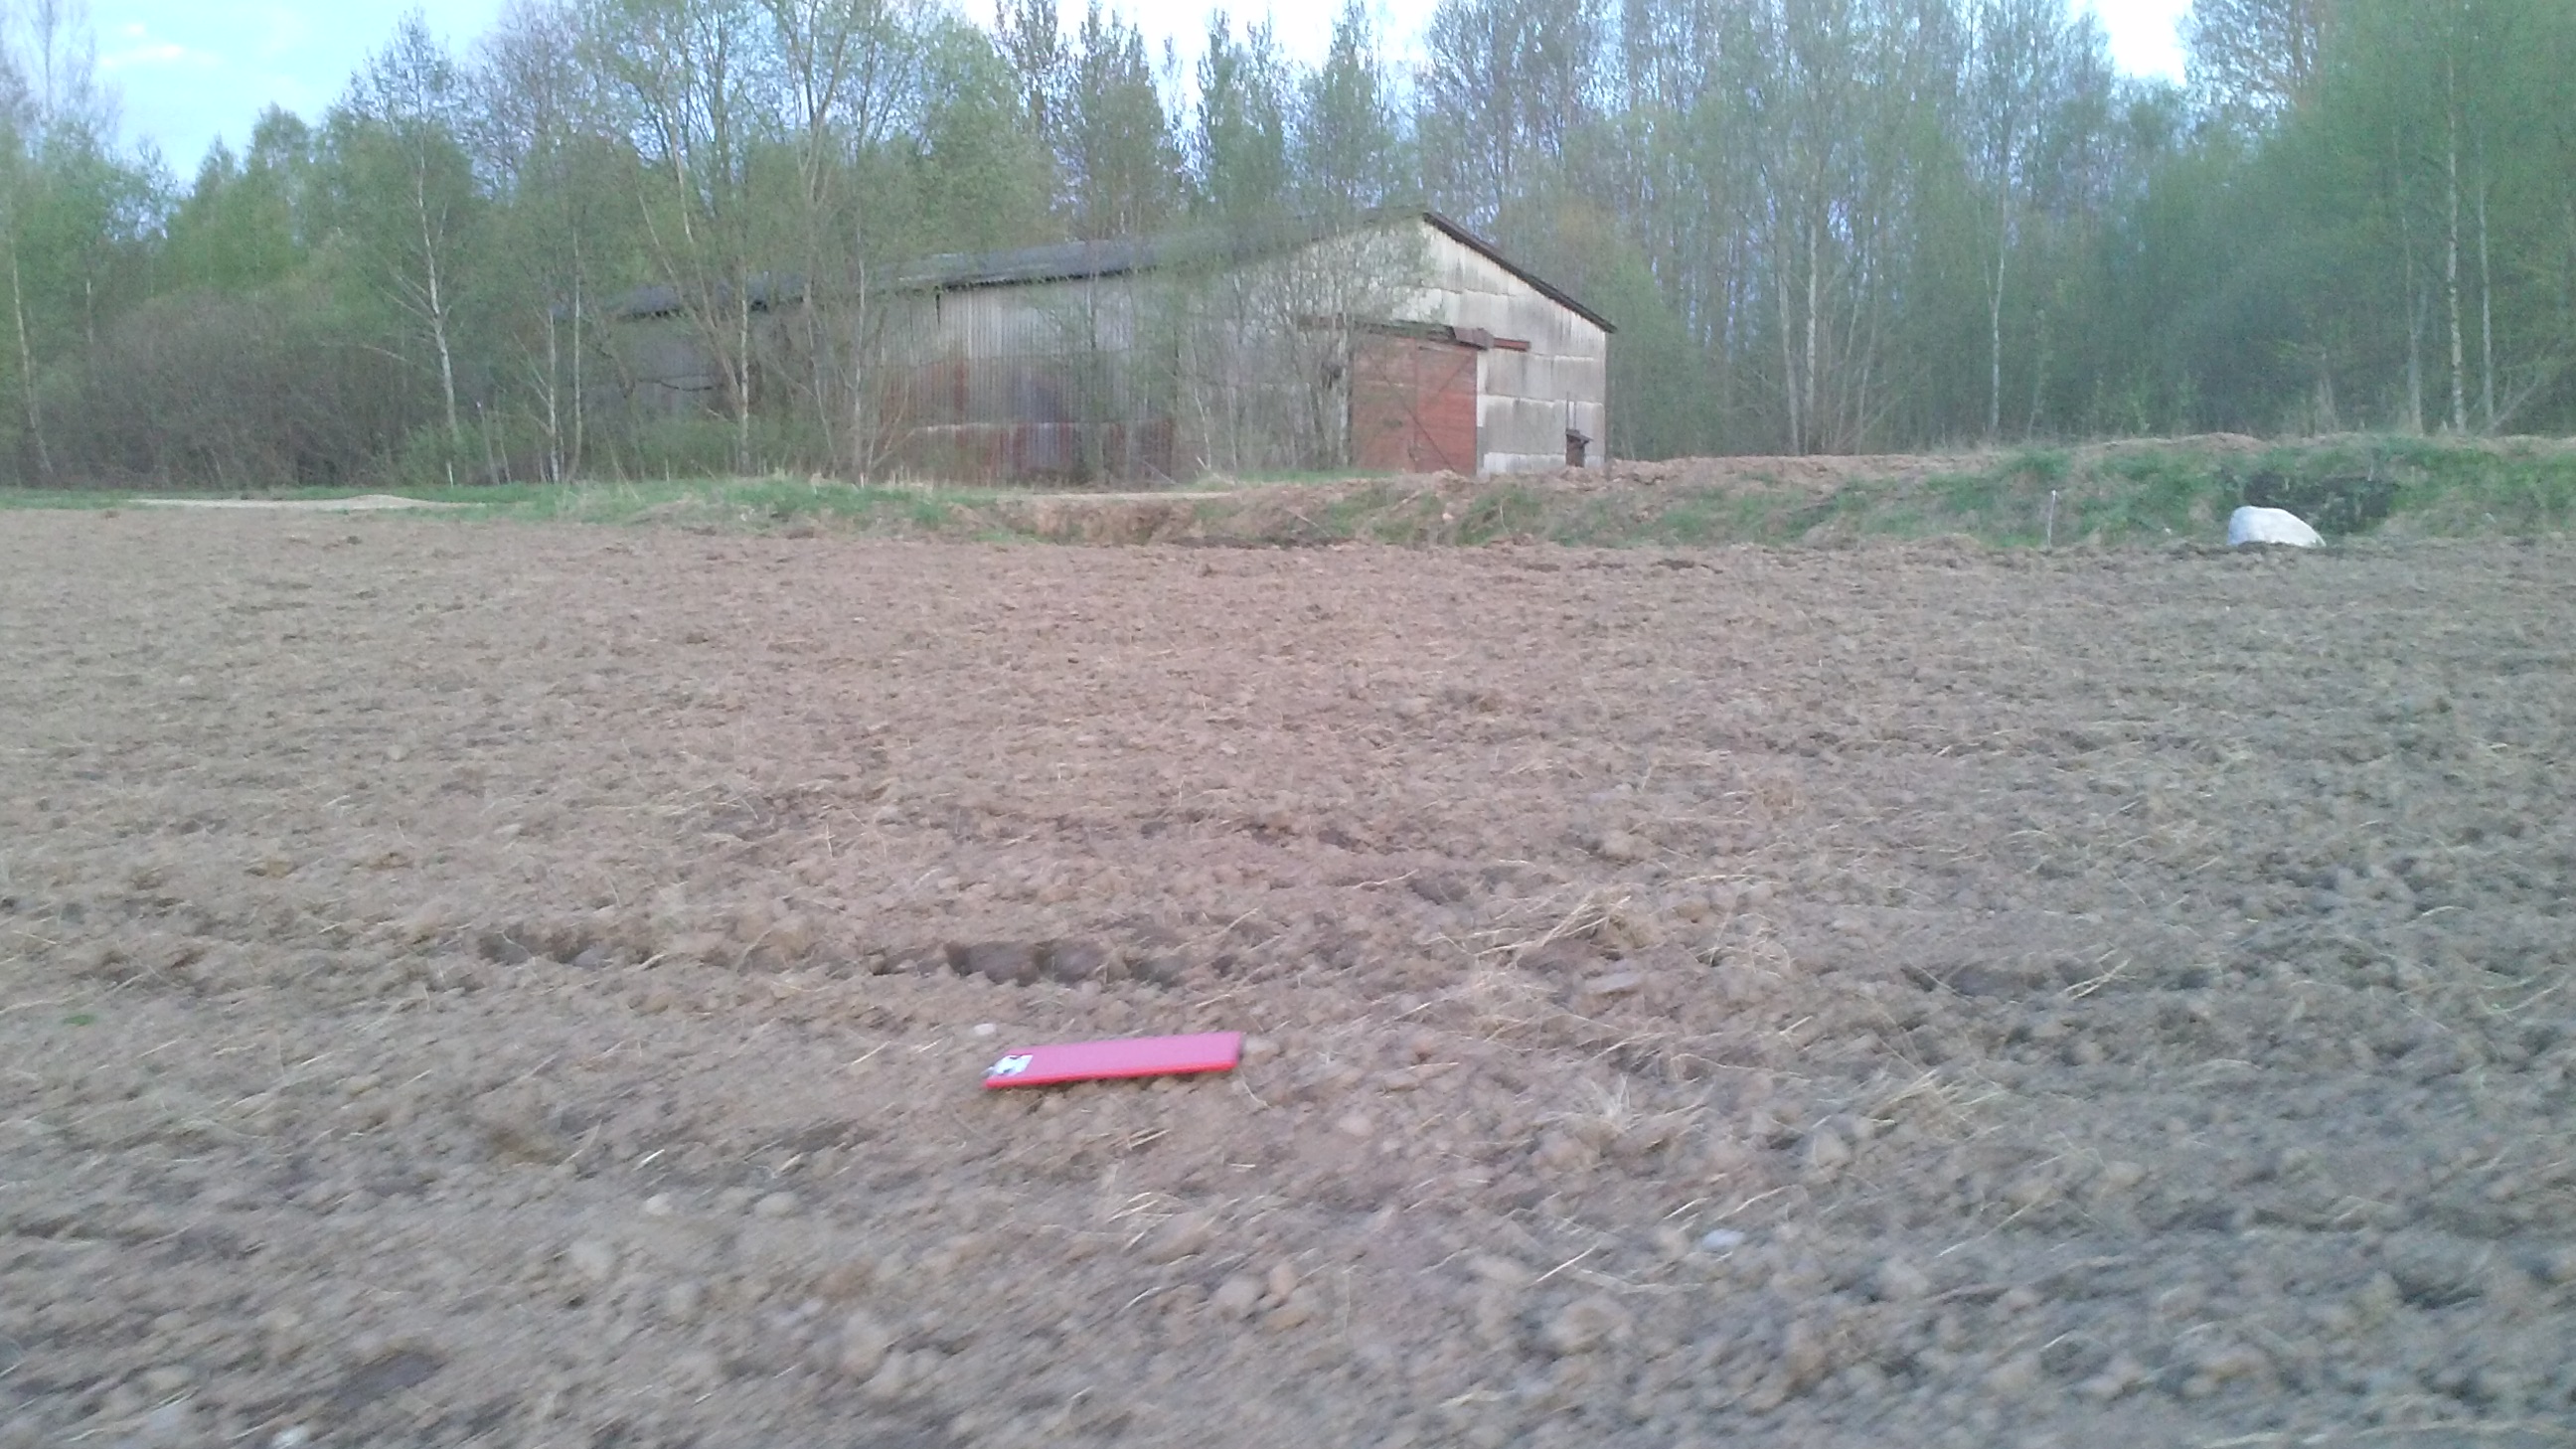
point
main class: Cropland
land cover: Oats
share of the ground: < 10 %
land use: Agriculture (excluding fallow land and kitchen gardens)
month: May
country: LV
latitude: 55.9366
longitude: 27.5860
